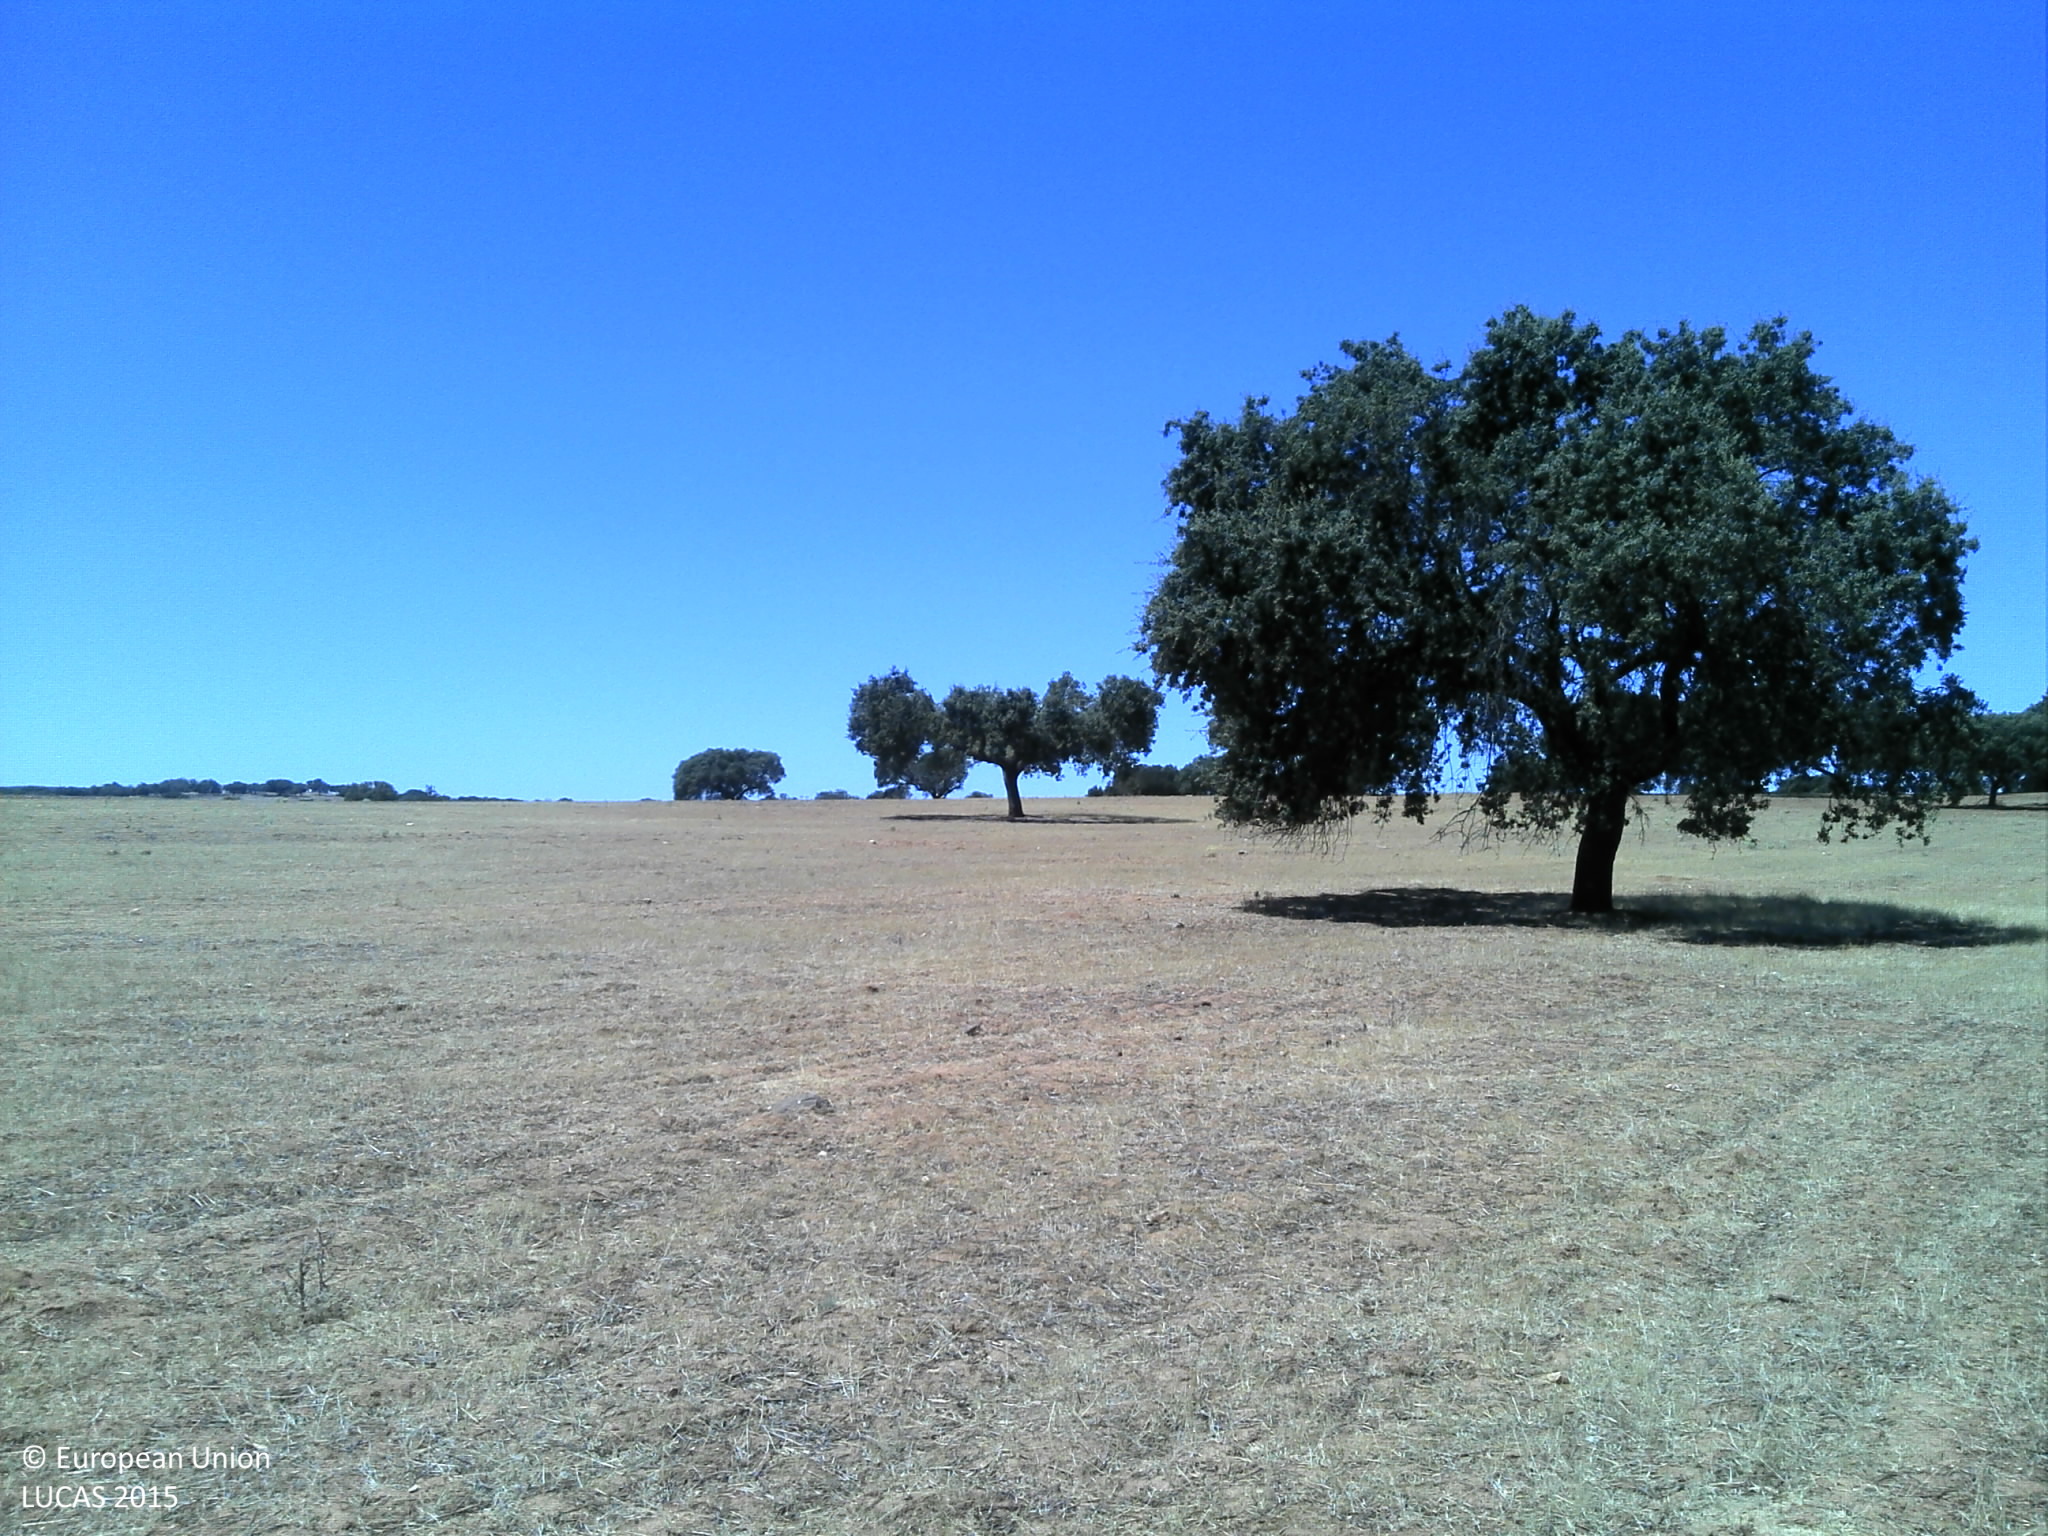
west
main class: Grassland
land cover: Grassland without tree/shrub cover
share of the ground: 10 - 25 %
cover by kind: unconsolidated bare surface 80 %, herbaceous plants 20 %
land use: Agriculture (excluding fallow land and kitchen gardens)
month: July
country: PT
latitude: 38.8836
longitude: -7.5003
